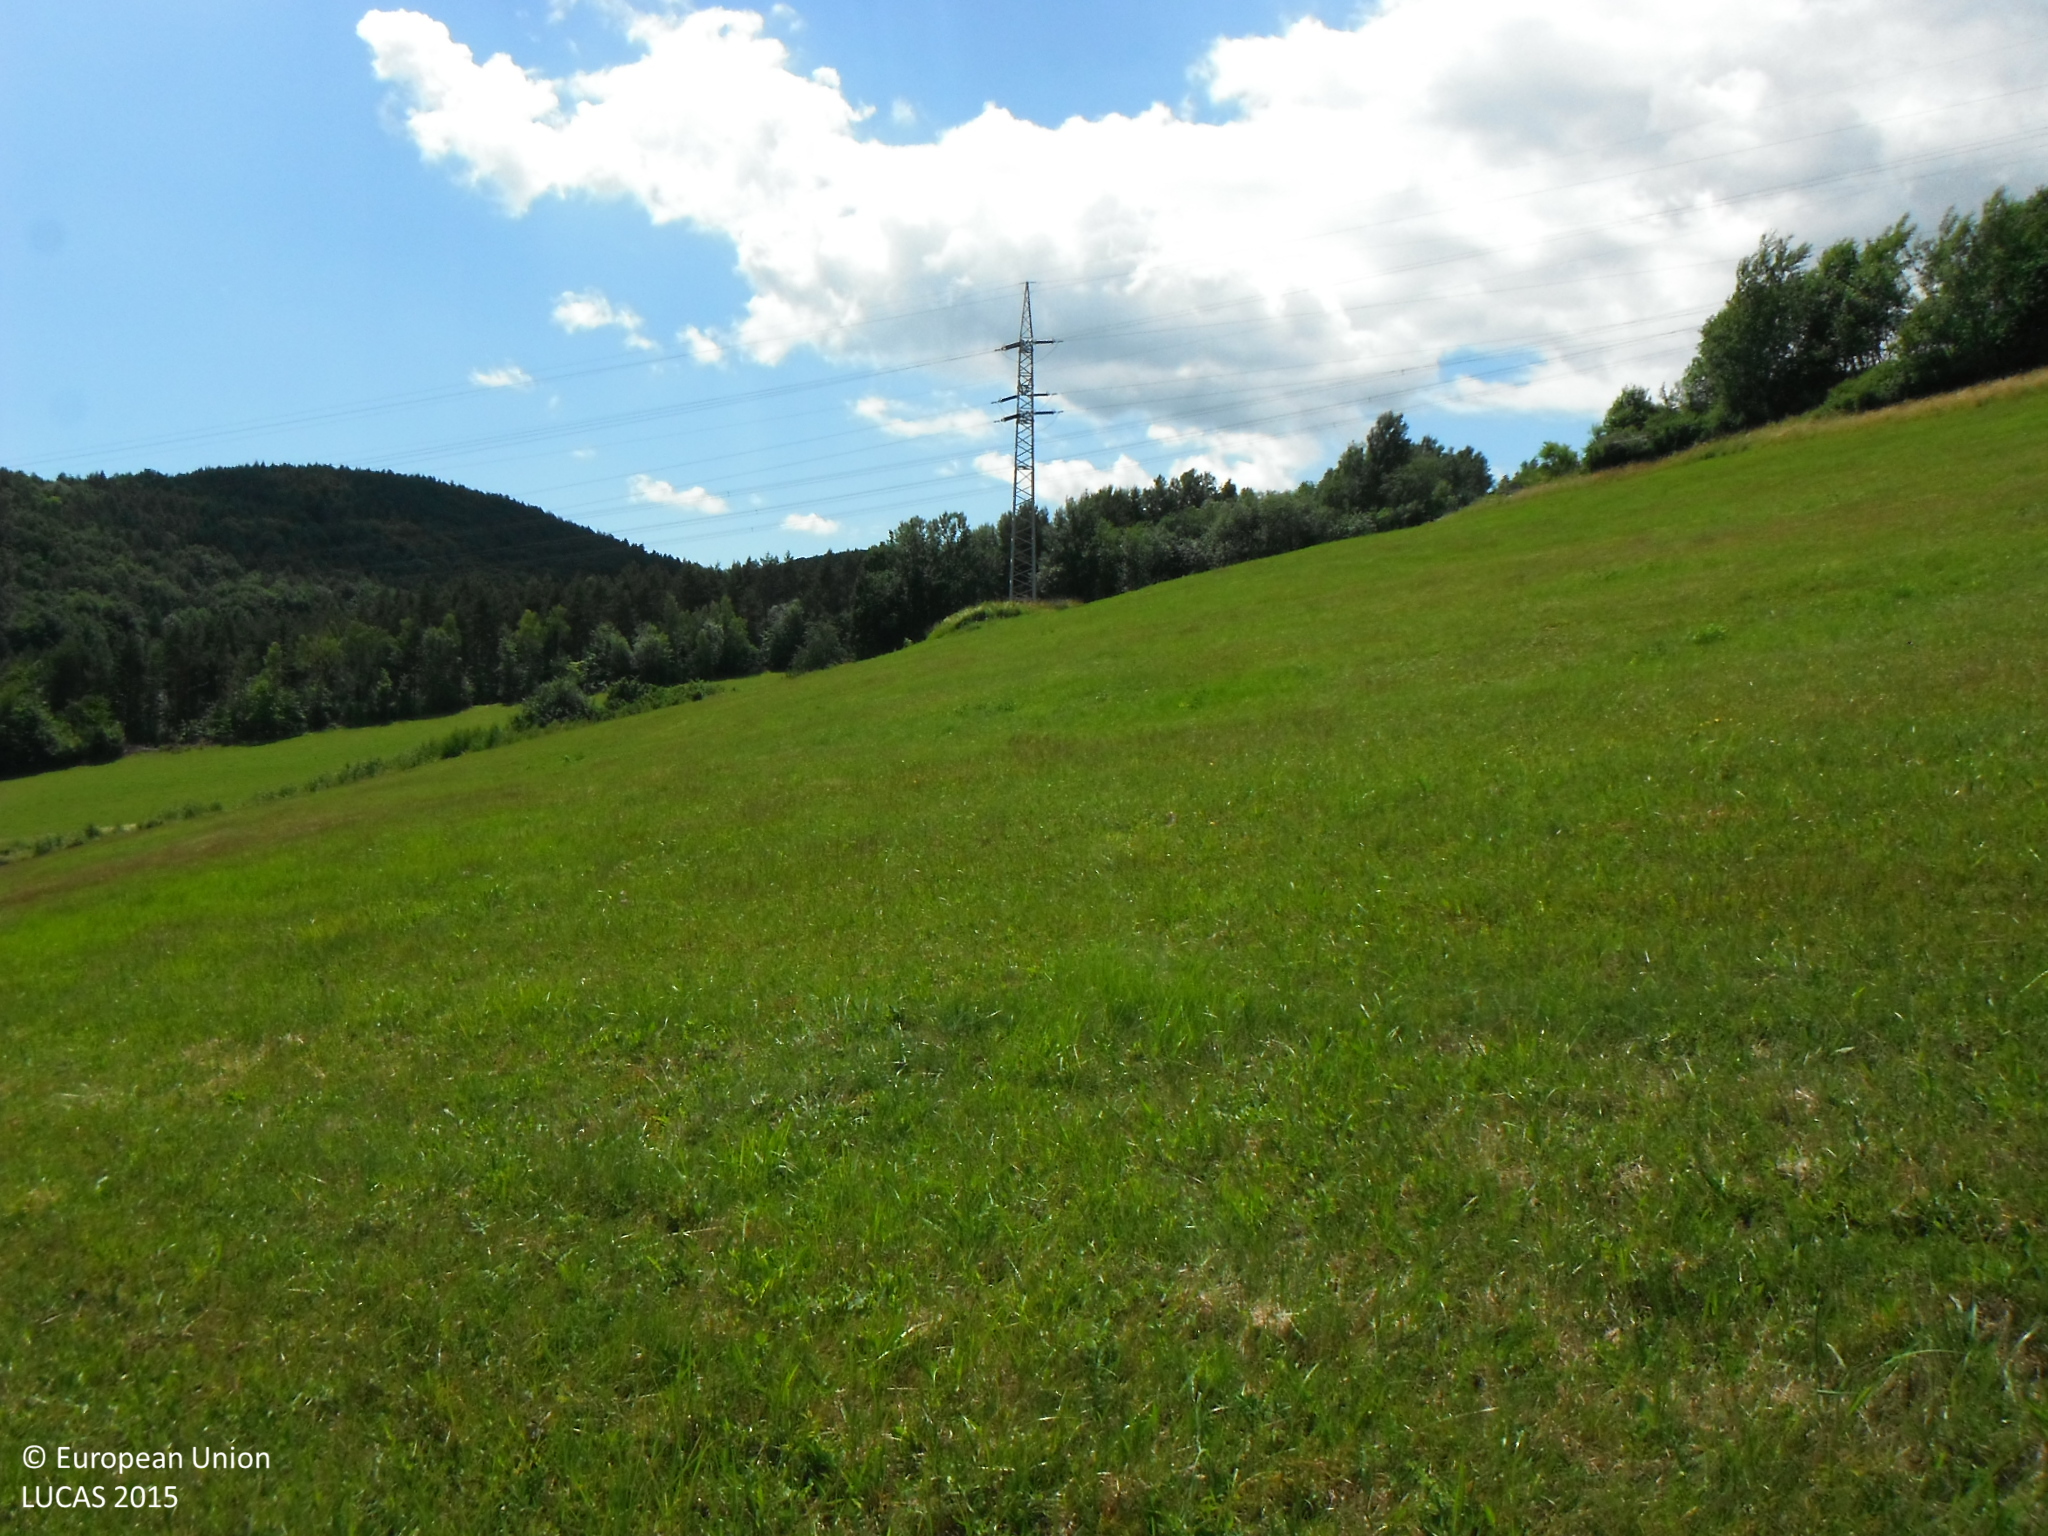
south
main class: Grassland
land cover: Grassland without tree/shrub cover
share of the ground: > 75 %
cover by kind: herbaceous plants 100 %
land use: Agriculture (excluding fallow land and kitchen gardens)
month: June
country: SK
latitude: 48.9078
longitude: 21.1633
